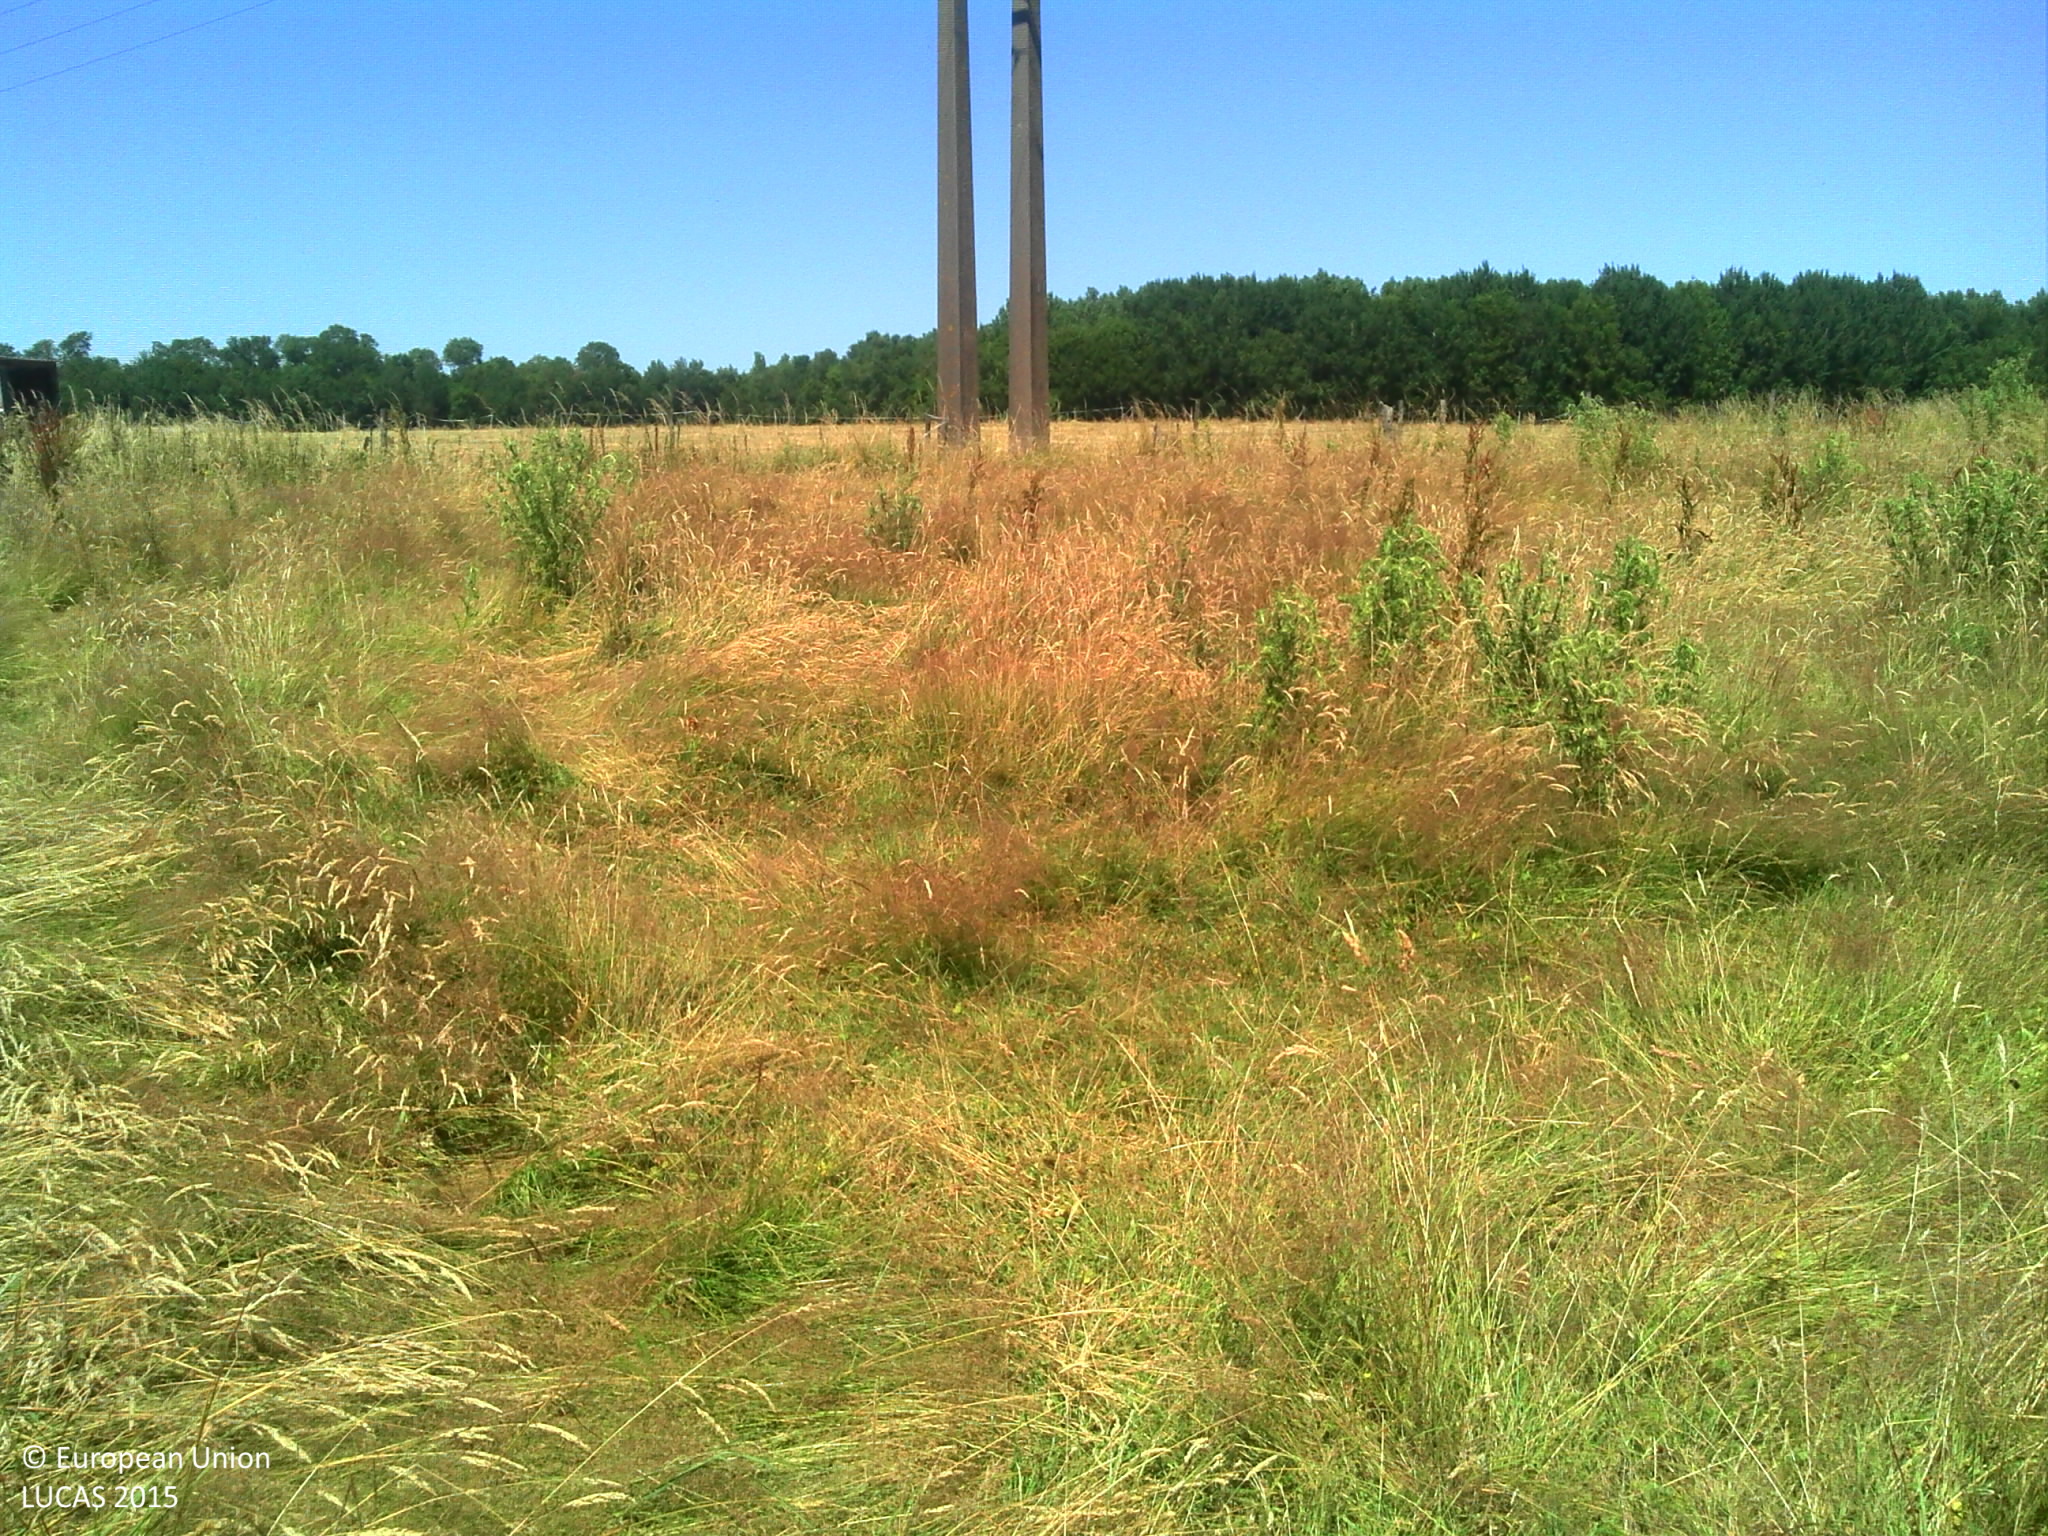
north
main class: Grassland
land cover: Grassland without tree/shrub cover
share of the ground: > 75 %
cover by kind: herbaceous plants 100 %
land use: Agriculture (excluding fallow land and kitchen gardens)
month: June
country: FR
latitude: 48.9413
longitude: 3.3164
